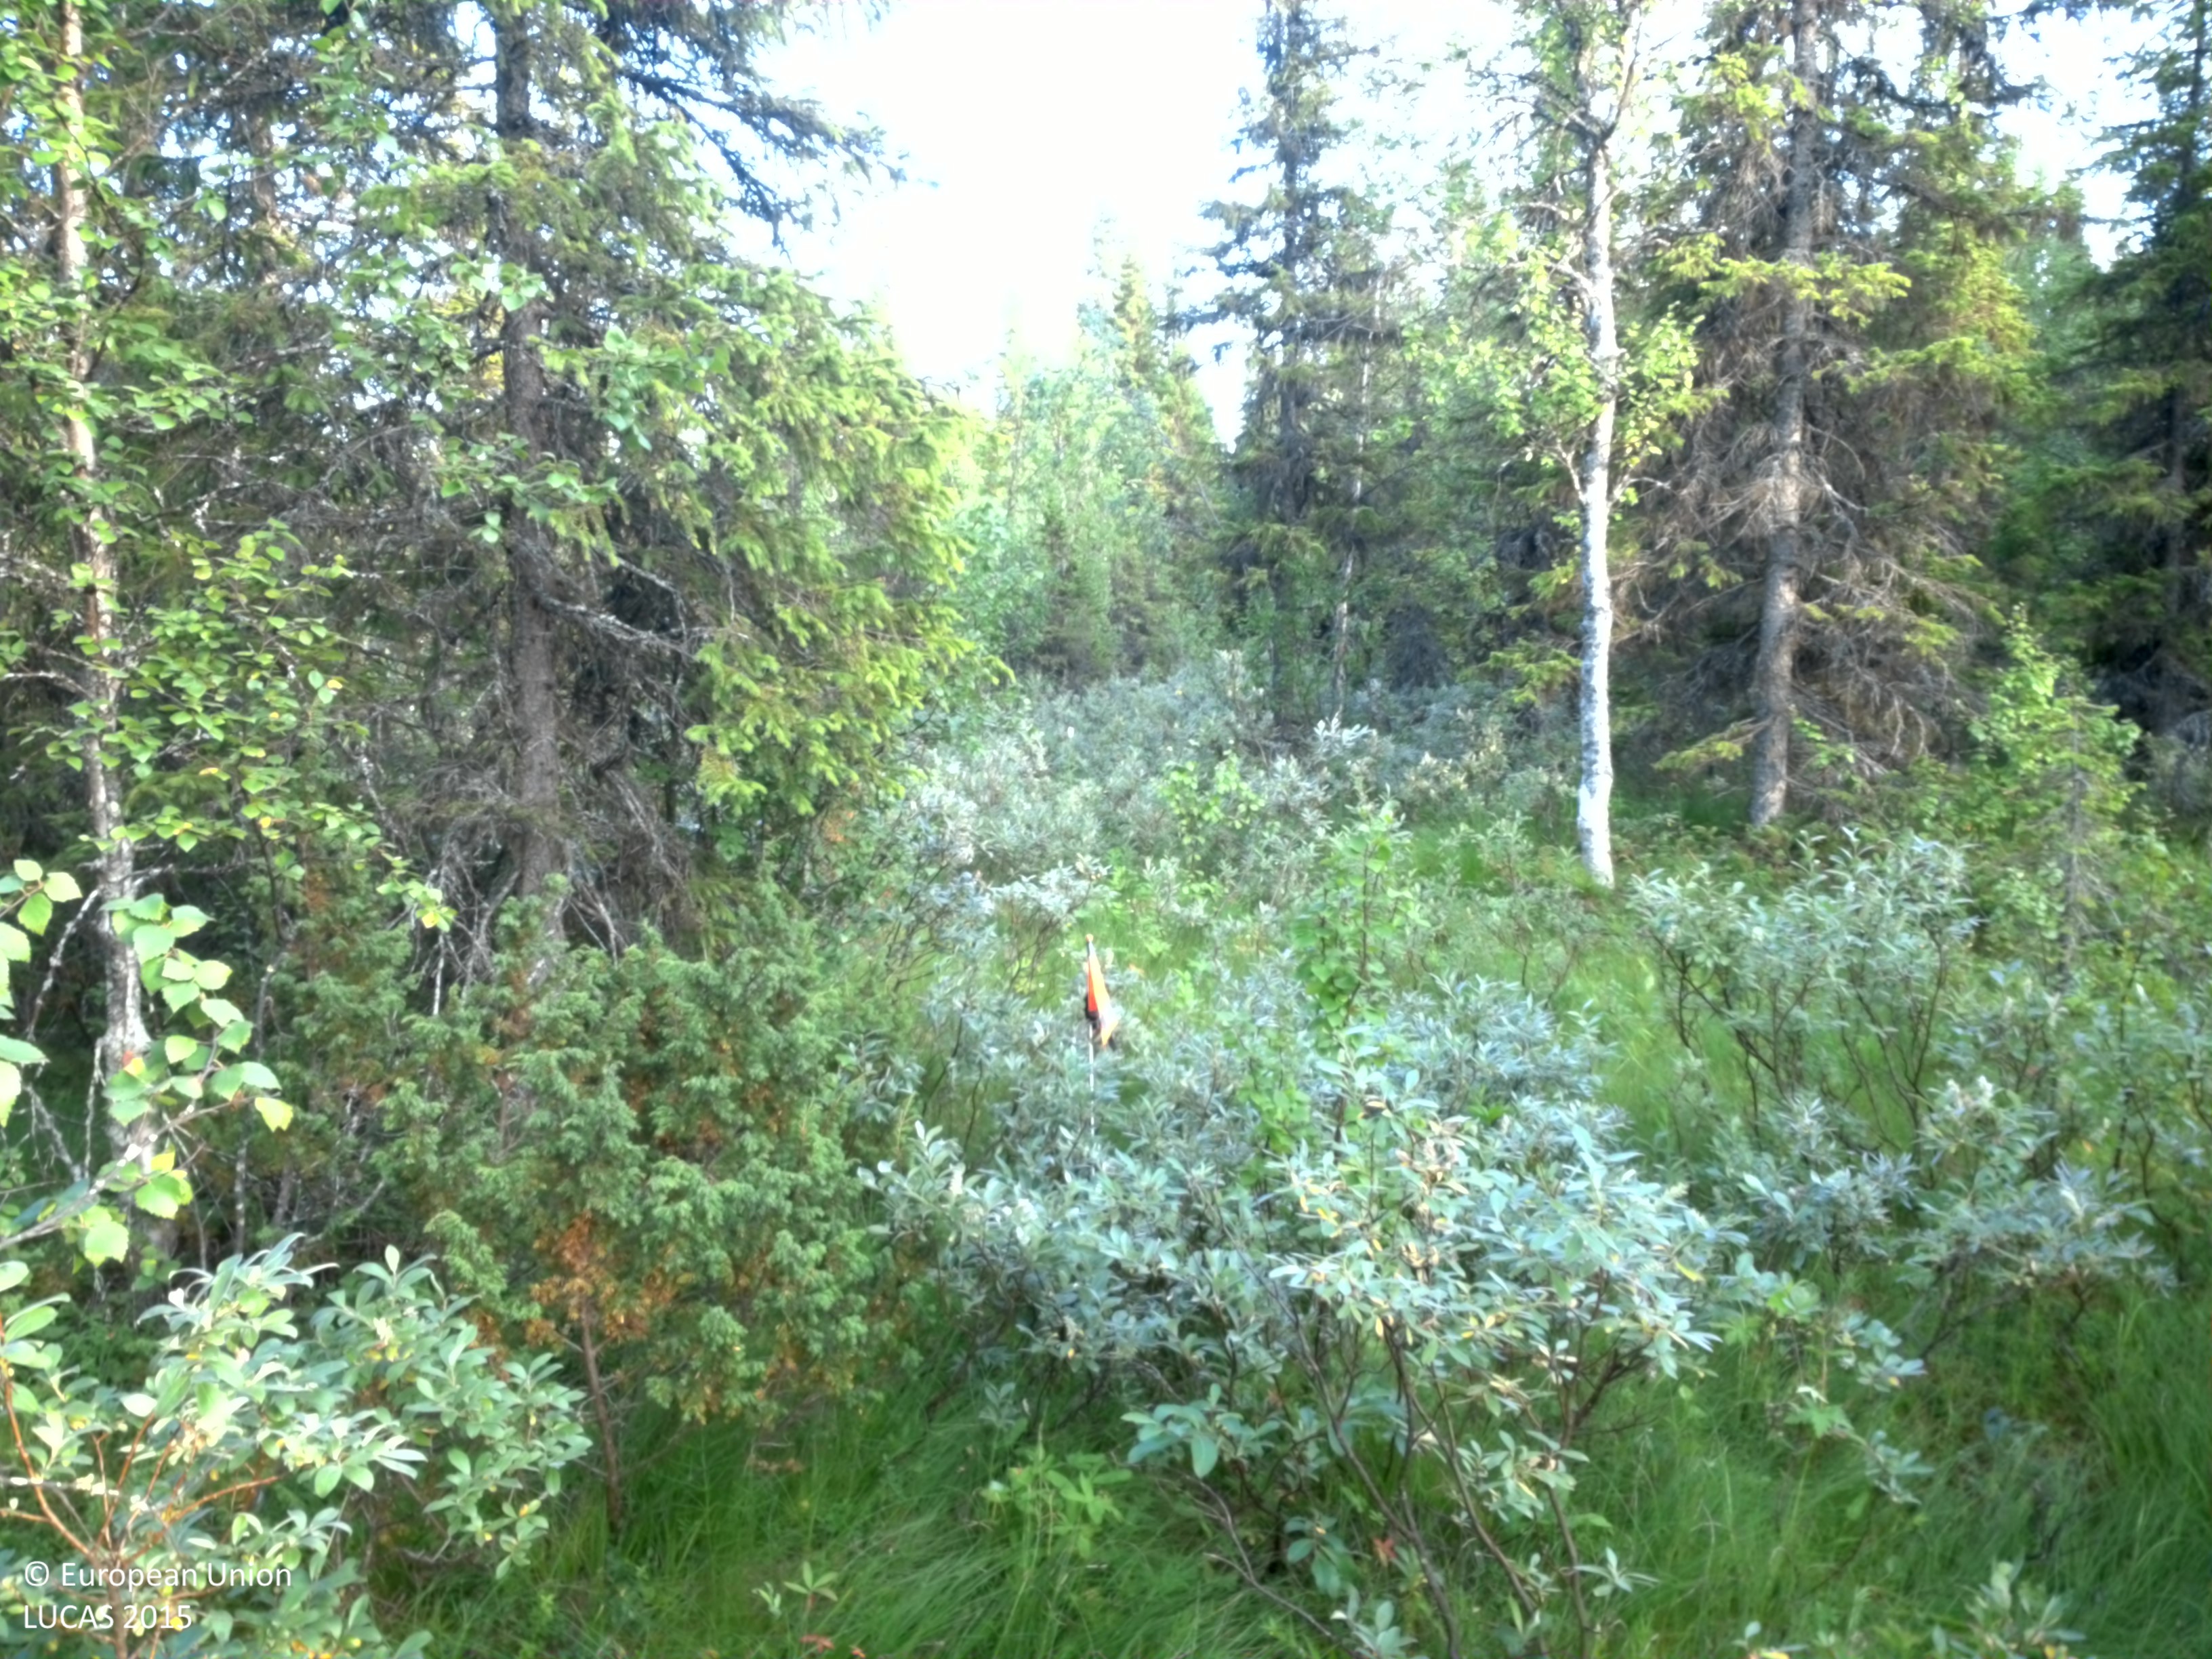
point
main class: Woodland
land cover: Spruce dominated mixed woodland
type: boreal forest
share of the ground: 25 - 50 %
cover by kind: coniferous forest trees 30 %, shrubs 25 %, herbaceous plants 25 %, broadleaved forest trees 15 %, lichens and mosses 5 %
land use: Forestry
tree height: > 5 m
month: August
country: SE
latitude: 64.7167
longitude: 16.0739
